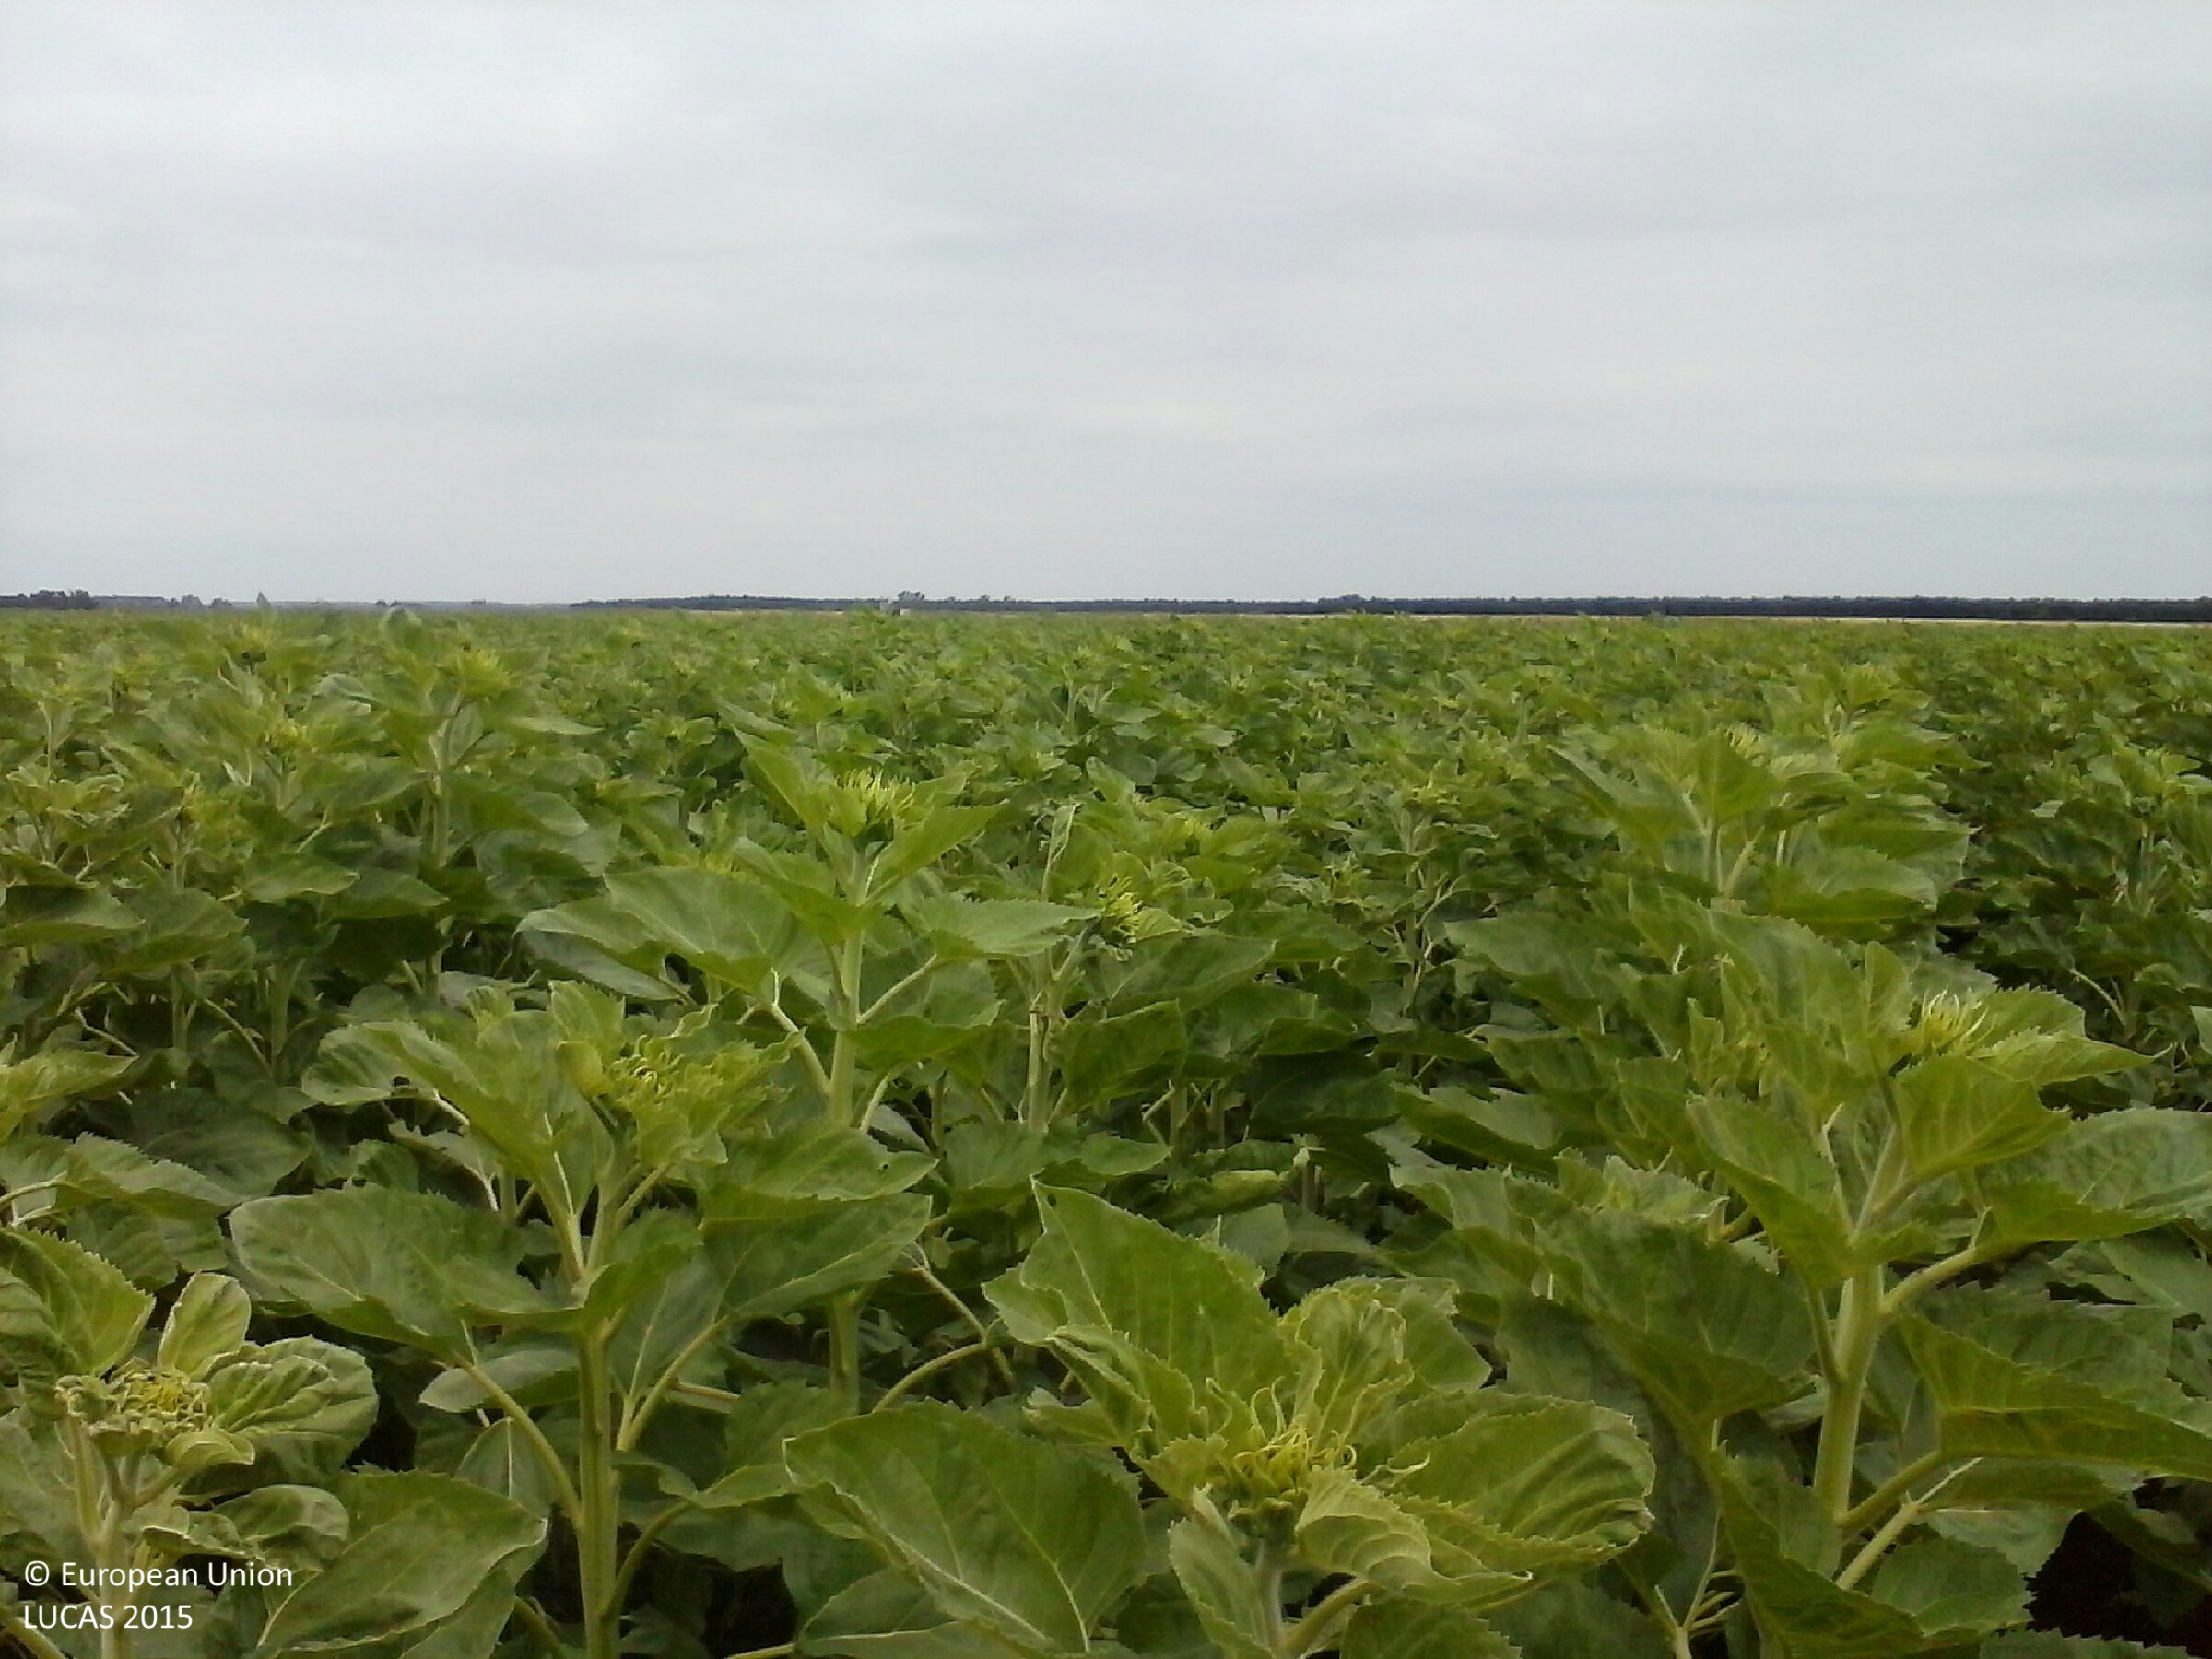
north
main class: Cropland
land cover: Sunflower
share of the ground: > 75 %
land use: Agriculture (excluding fallow land and kitchen gardens)
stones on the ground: < 10 %
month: June
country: HU
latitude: 46.1798
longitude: 20.2959
